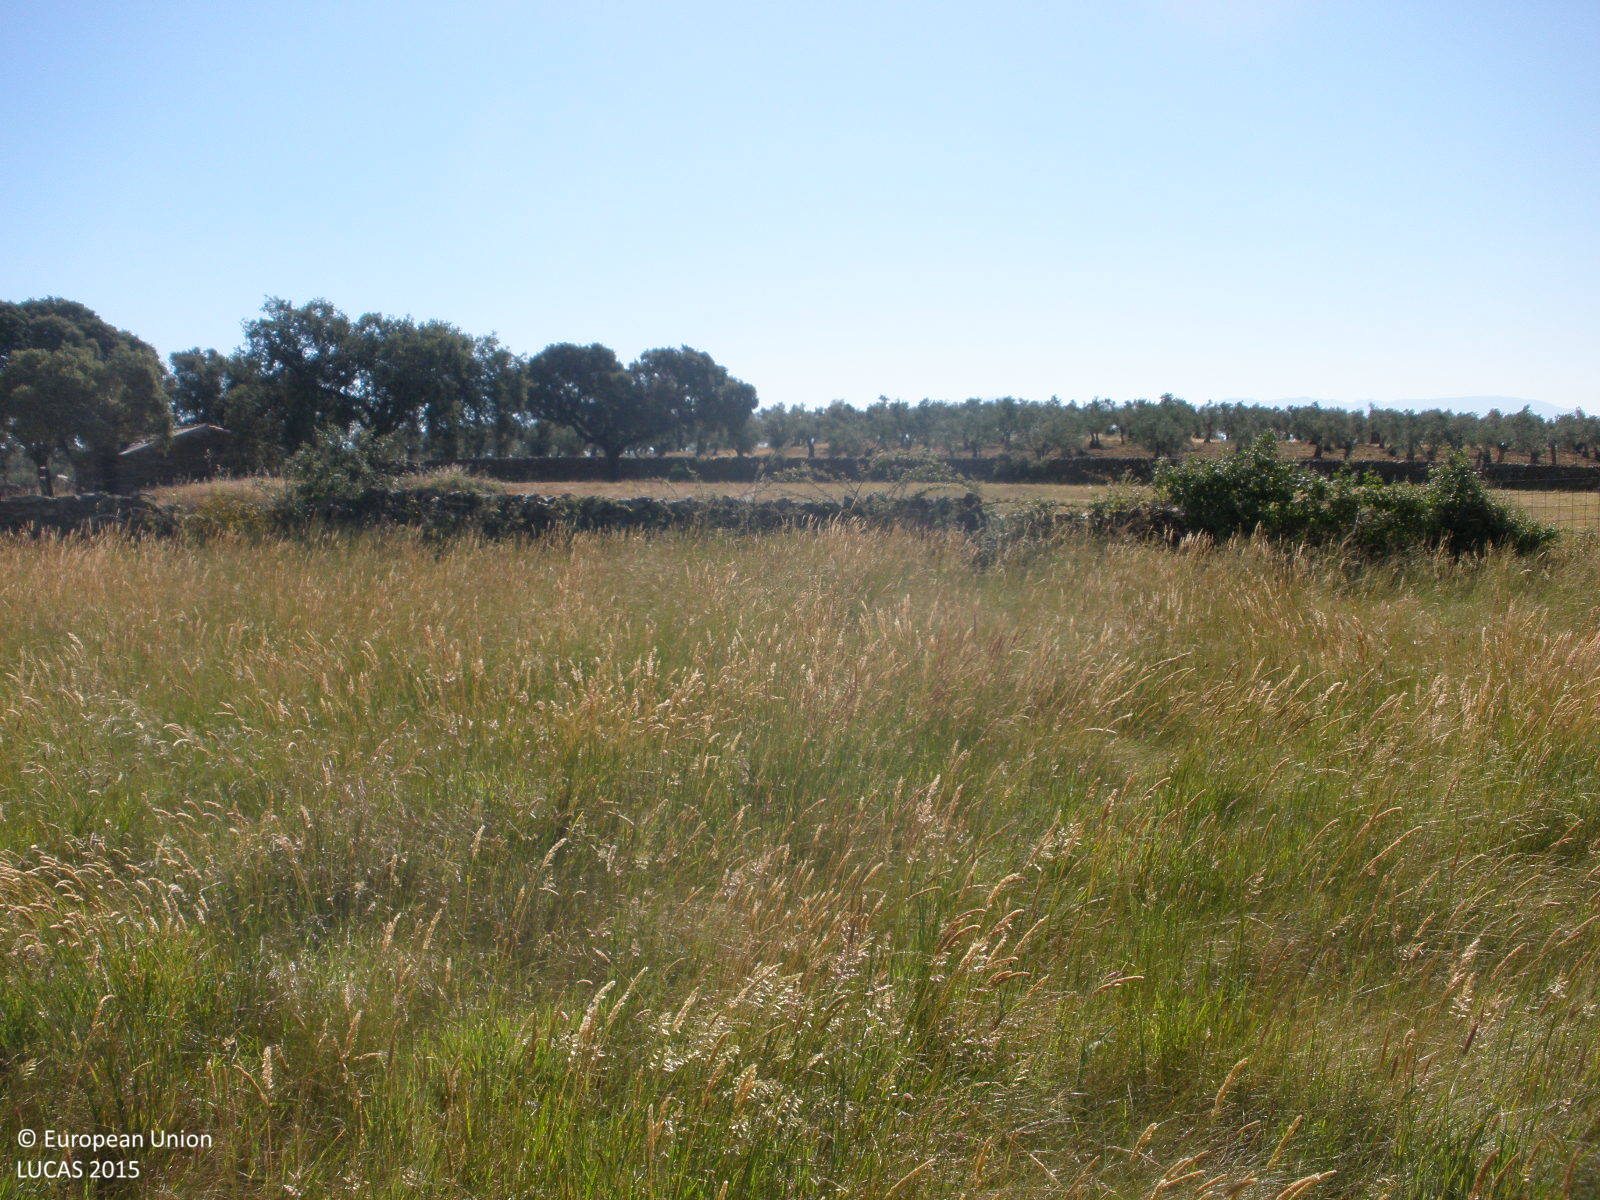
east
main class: Grassland
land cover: Grassland without tree/shrub cover
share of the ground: > 75 %
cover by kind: herbaceous plants 100 %
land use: Agriculture (excluding fallow land and kitchen gardens)
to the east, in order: Grassland without tree/shrub cover; Dry stone walls; Grassland without tree/shrub cover; Dry stone walls; Tracks; Fences; Olive groves; Dry stone walls; Shrubland without tree cover; Grassland without tree/shrub cover
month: May
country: ES
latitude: 40.2398
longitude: -6.2883
